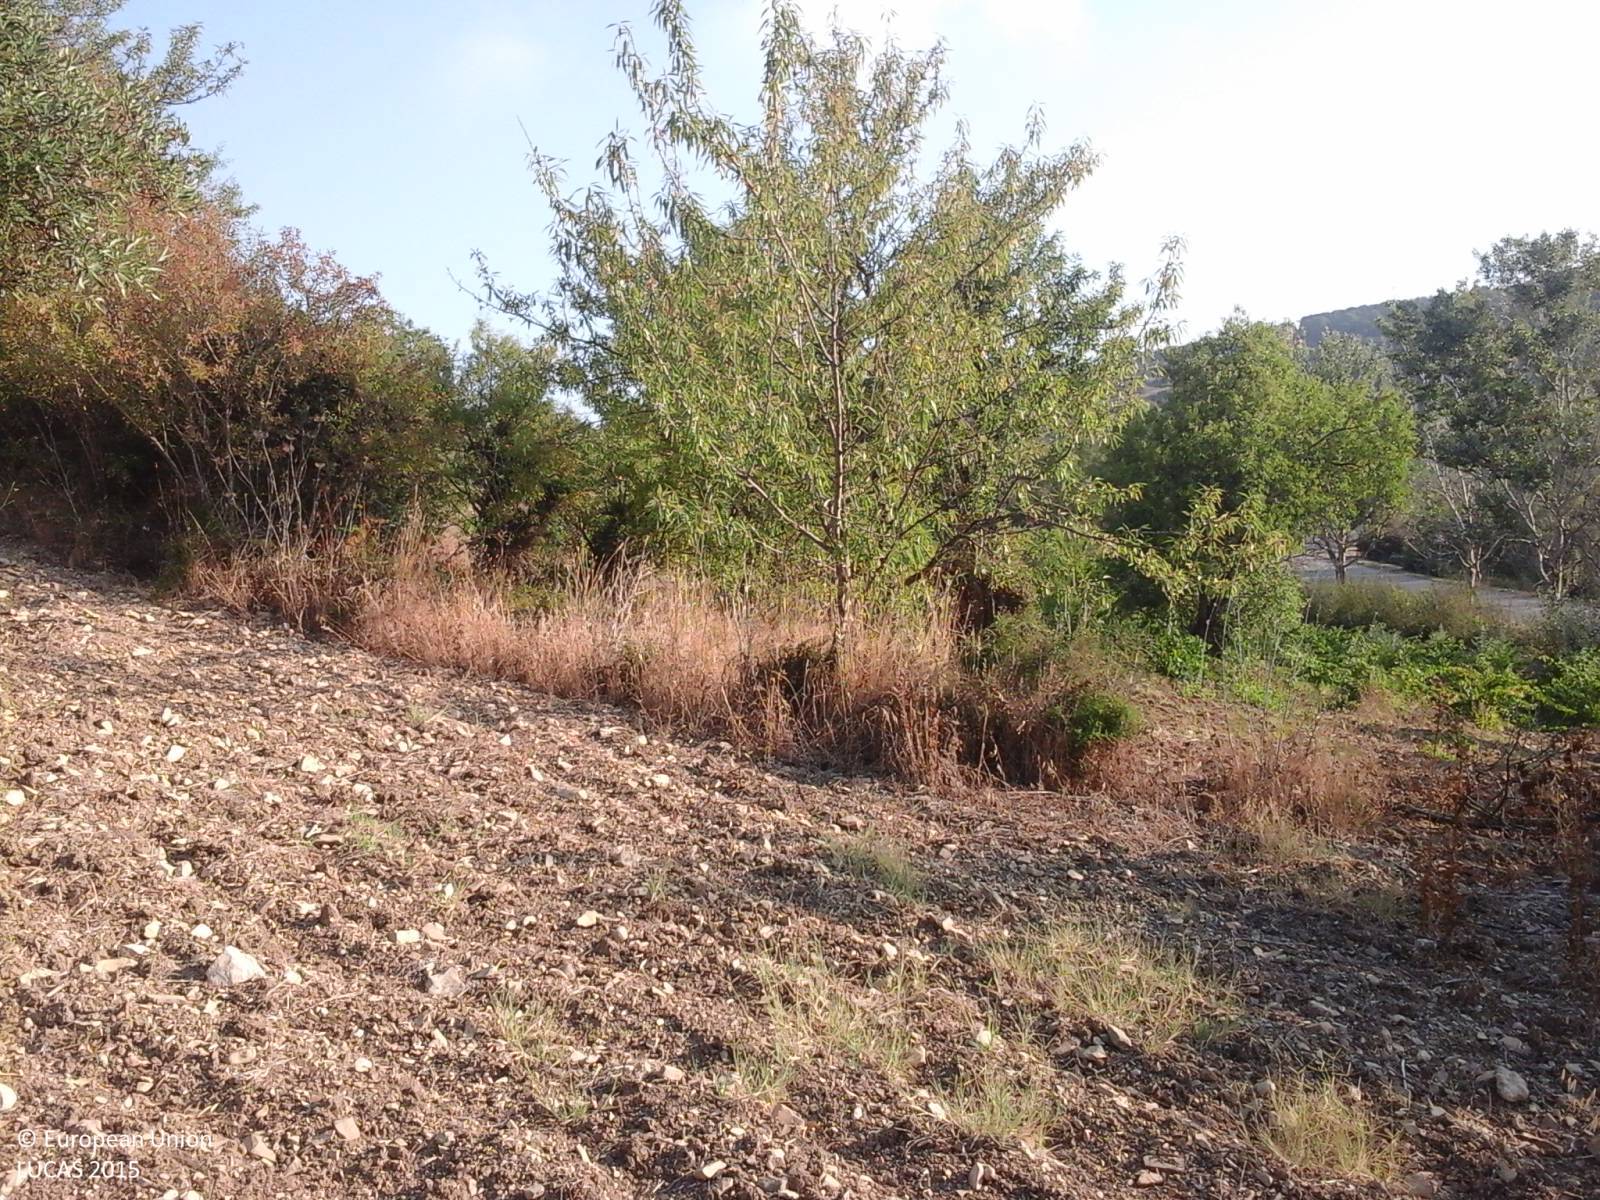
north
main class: Cropland
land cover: Olive groves
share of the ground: > 75 %
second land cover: Other bare soil
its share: > 75 %
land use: Agriculture (excluding fallow land and kitchen gardens)
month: July
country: IT
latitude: 39.6268
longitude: 8.8533
